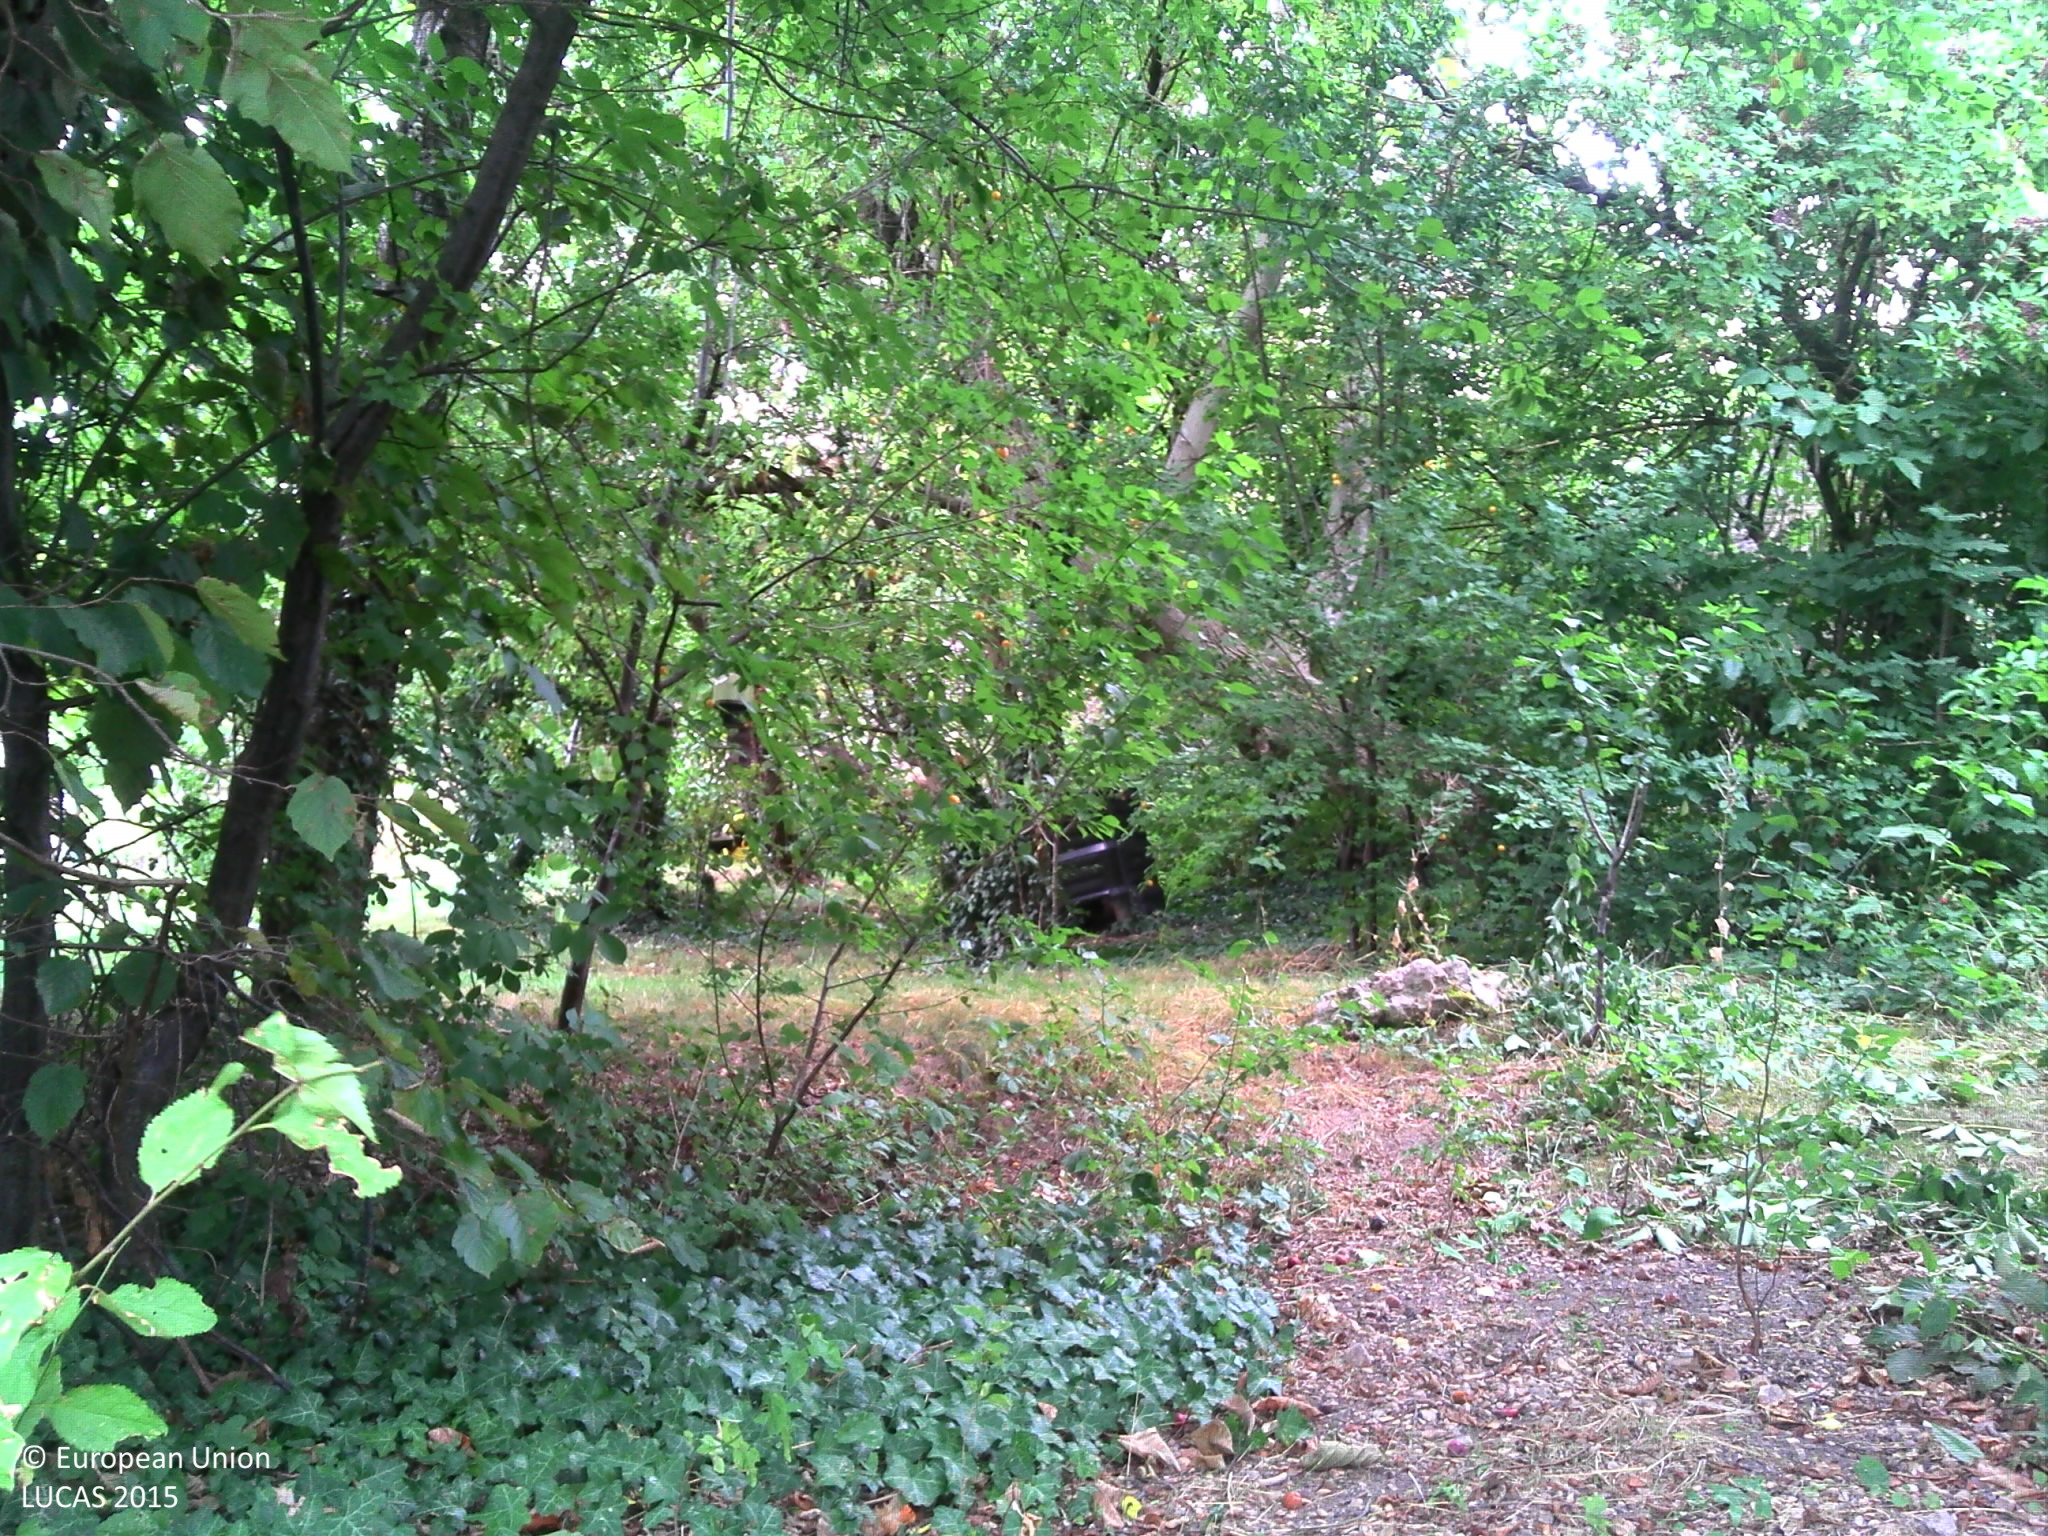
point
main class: Woodland
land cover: Broadleaved woodland
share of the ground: > 75 %
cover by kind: broadleaved forest trees 90 %, herbaceous plants 10 %
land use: Residential
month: August
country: FR
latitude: 44.8772
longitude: 4.5750
